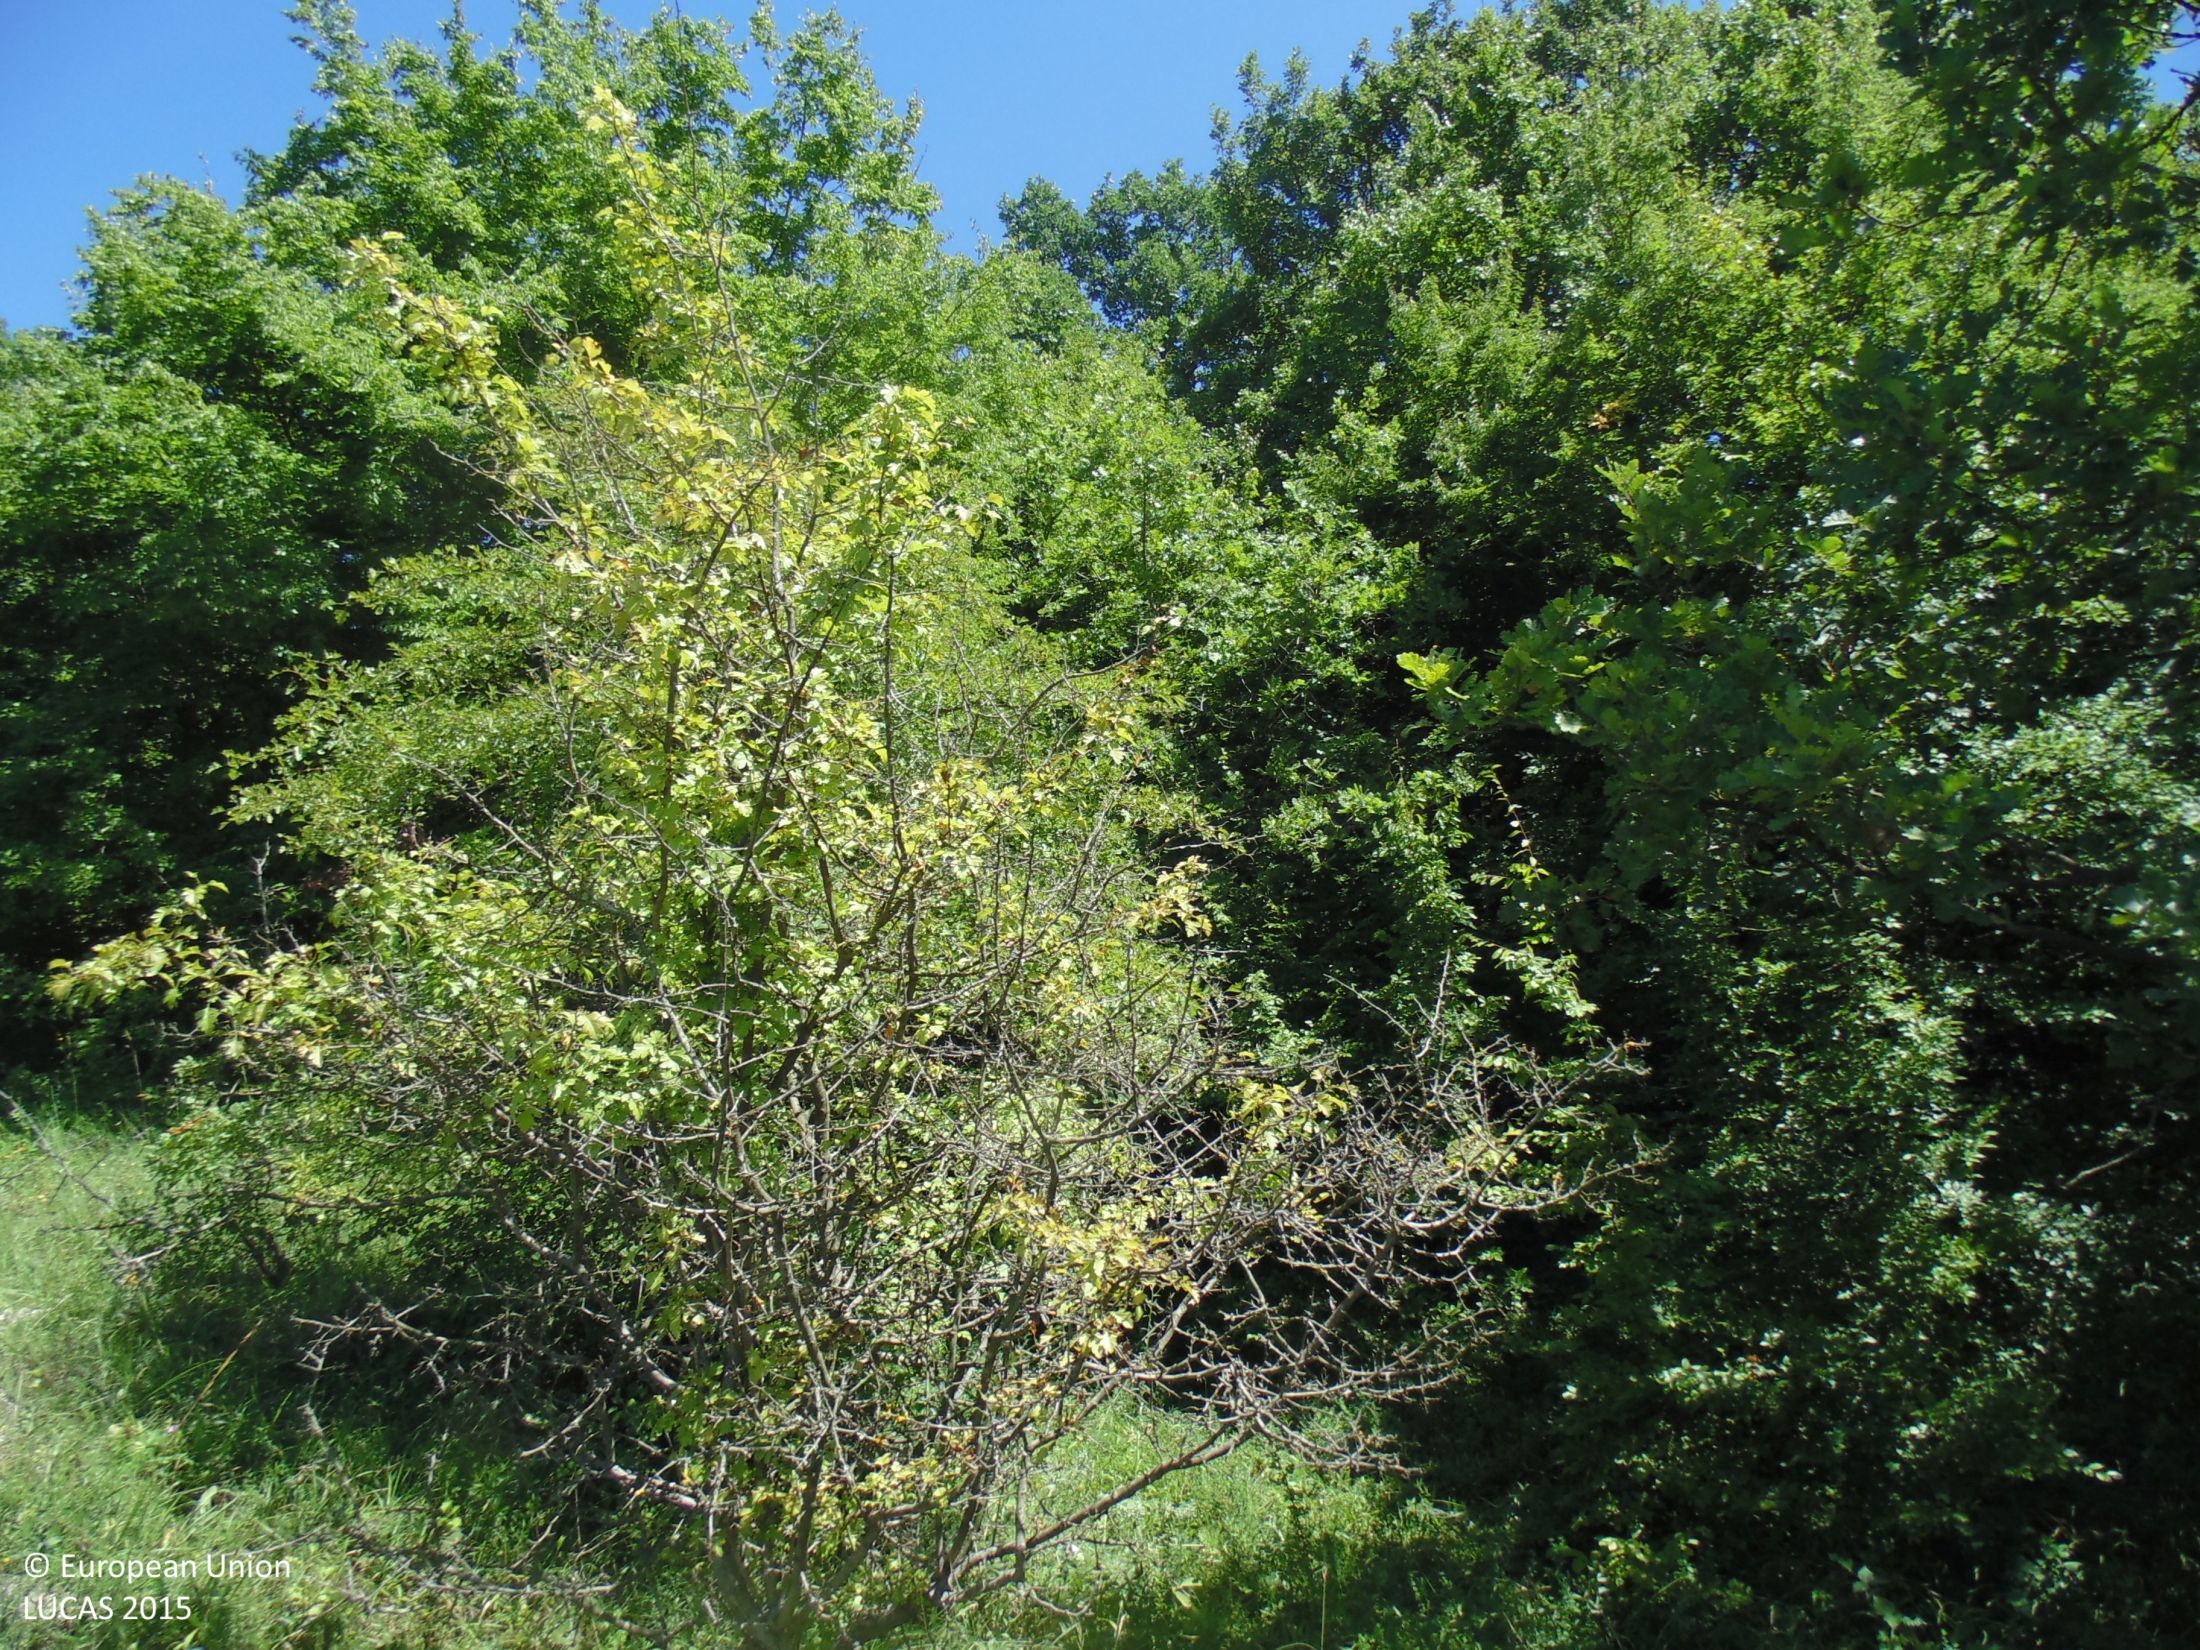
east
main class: Woodland
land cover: Broadleaved woodland
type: mesophytic deciduous forest
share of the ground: > 75 %
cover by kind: broadleaved forest trees 80 %, shrubs 15 %, consolidated bare surface 5 %
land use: Forestry
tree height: > 5 m
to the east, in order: Broadleaved woodland; Tracks; Pine dominated coniferous woodland; Broadleaved woodland; Shrubland without tree cover; Electric lines; Shrubland without tree cover; Pine dominated coniferous woodland
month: July
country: BG
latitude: 43.3953
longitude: 28.0603
